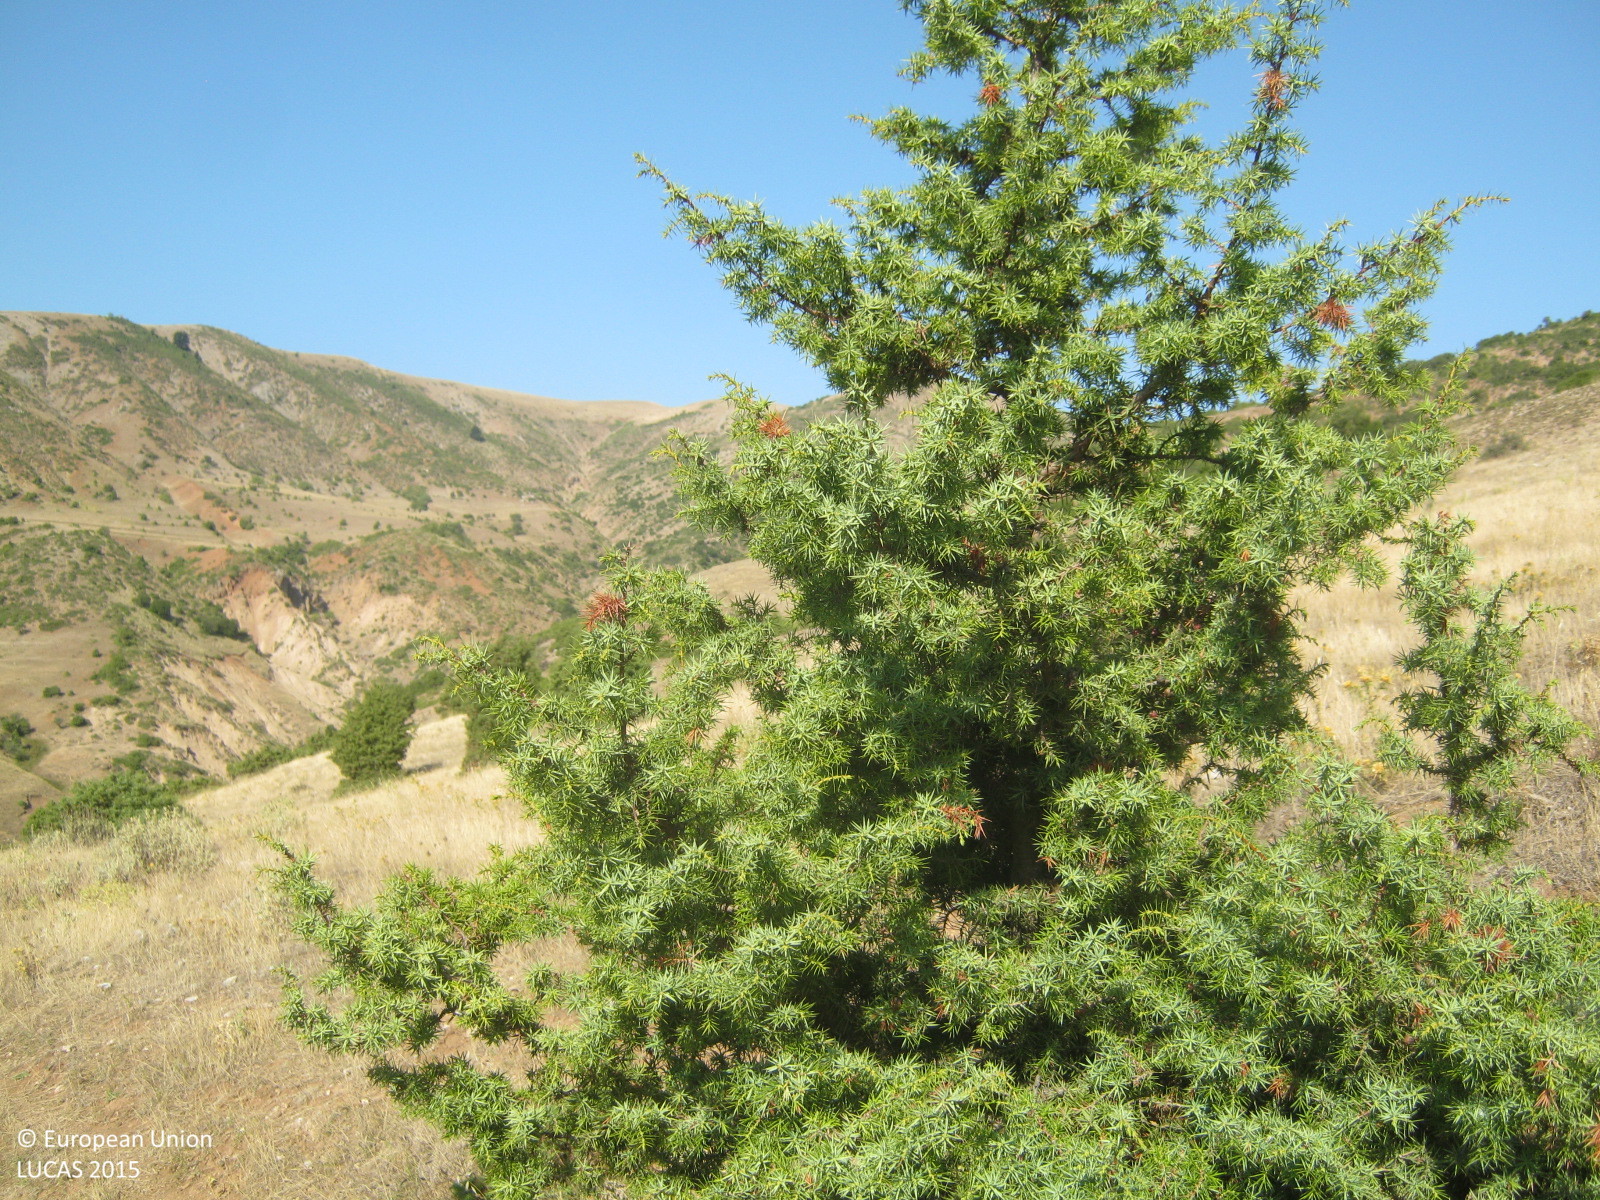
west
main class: Shrubland
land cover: Shrubland without tree cover
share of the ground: 25 - 50 %
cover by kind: herbaceous plants 65 %, shrubs 30 %, unconsolidated bare surface 5 %
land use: Semi-natural and natural areas not in use
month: September
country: GR
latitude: 38.0697
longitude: 22.1073
